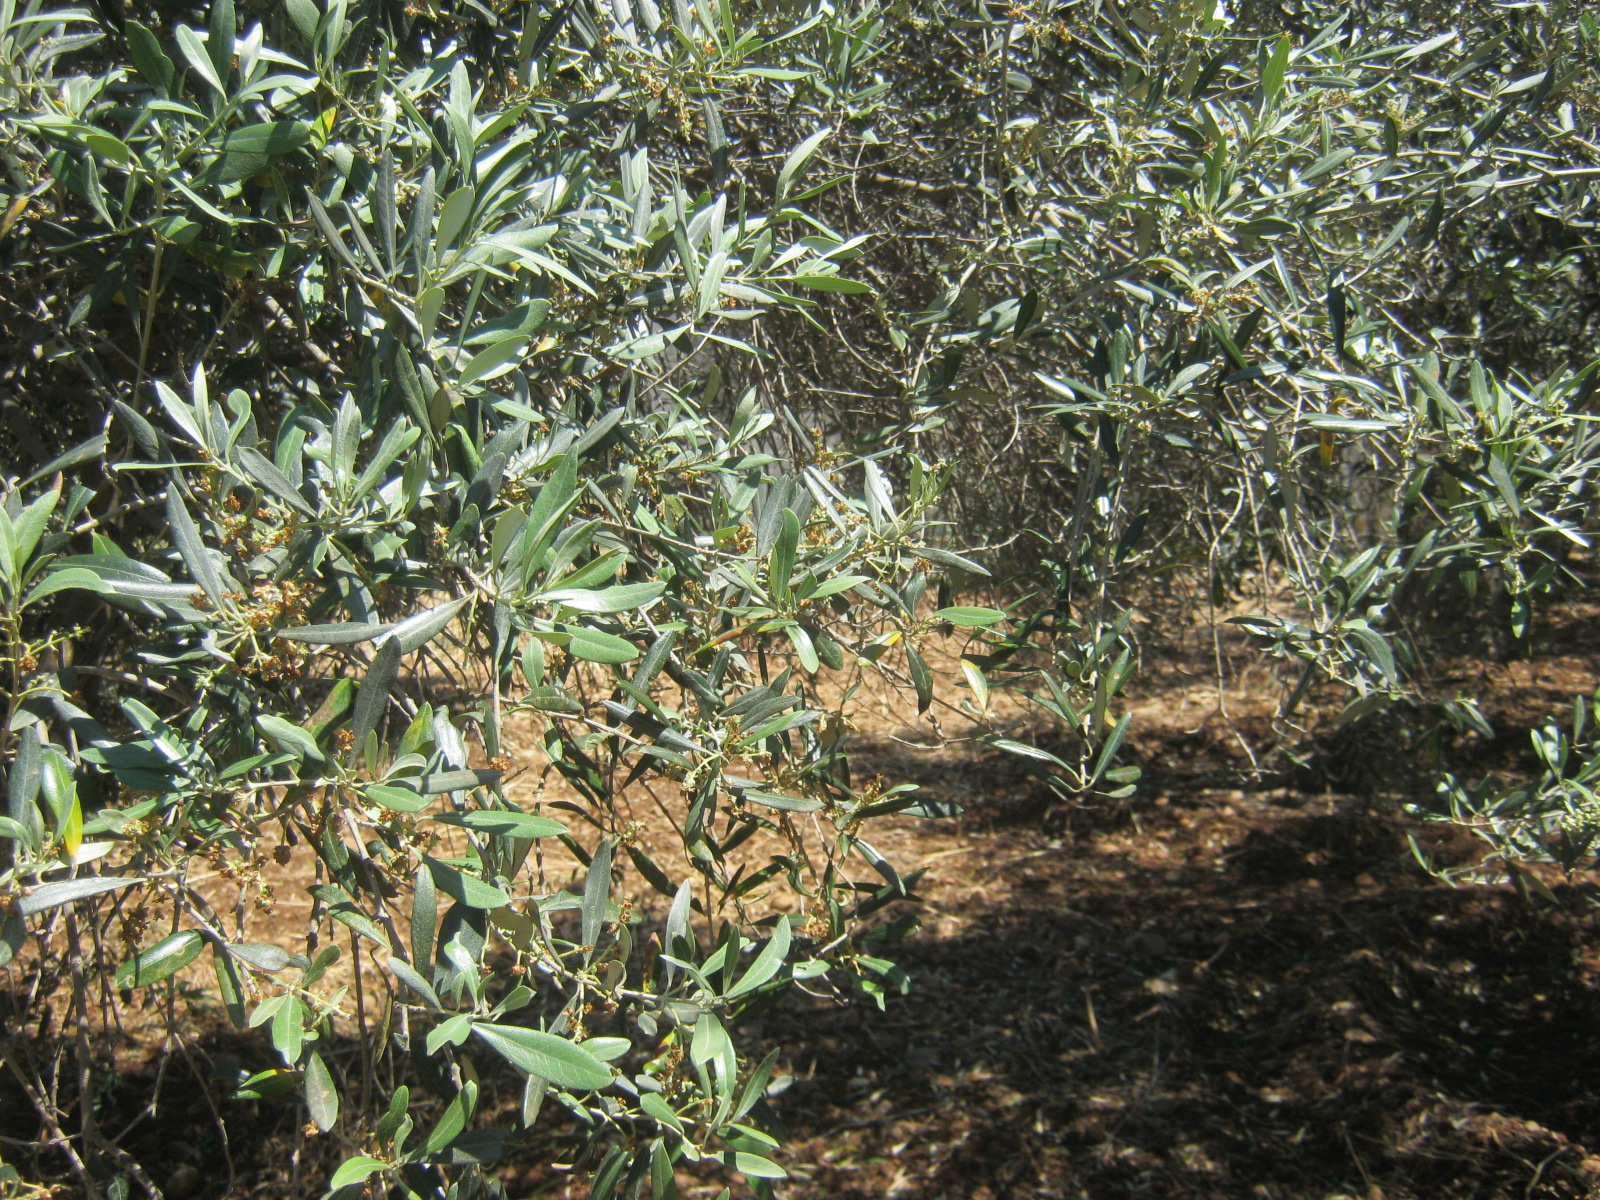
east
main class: Cropland
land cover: Olive groves
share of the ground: > 75 %
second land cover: Other bare soil
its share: > 75 %
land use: Kitchen garden
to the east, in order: Olive groves; Other bare soil; Barley; Spontaneously vegetated surfaces; Other fruit trees and berries; Olive groves; Grass margins; Rivers and streams; Olive groves; Artificial constructions in urban areas; Spontaneously vegetated surfaces
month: May
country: CY
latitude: 35.1395
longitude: 33.0420
